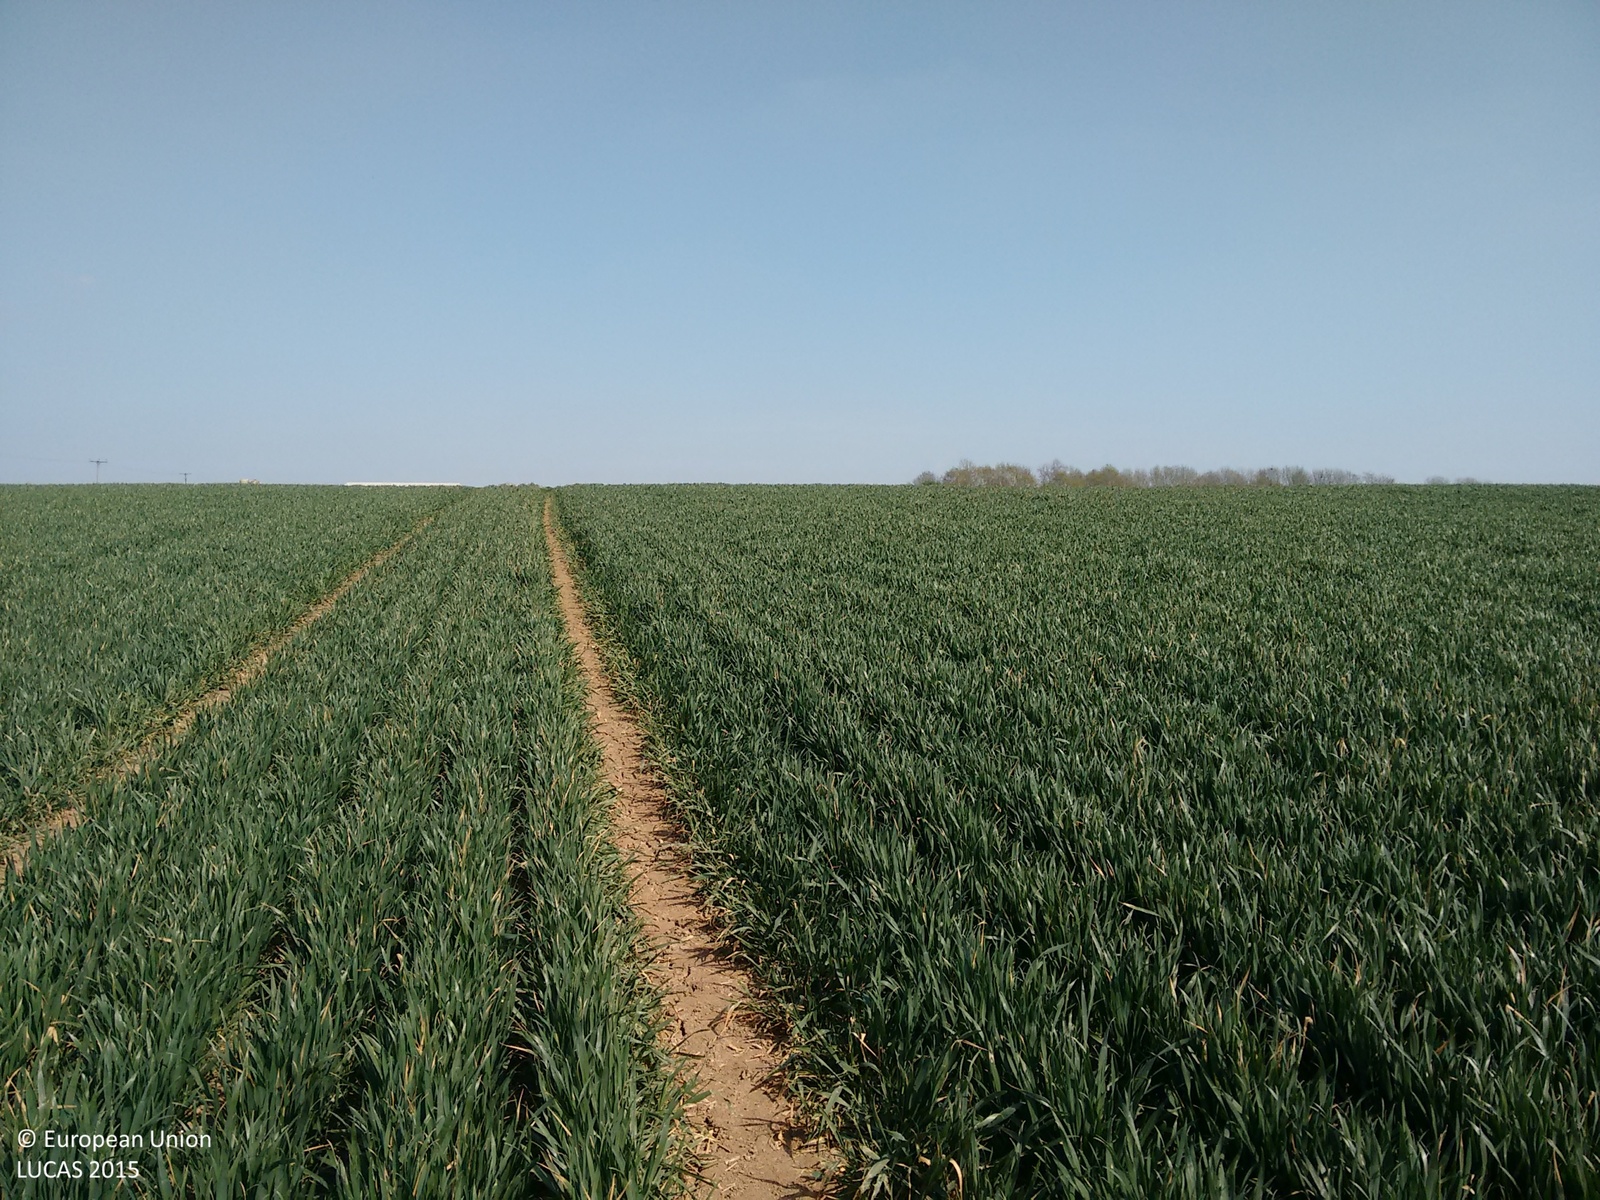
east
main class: Cropland
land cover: Common wheat
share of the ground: > 75 %
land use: Agriculture (excluding fallow land and kitchen gardens)
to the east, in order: Common wheat; Grass margins; Managed hedges; Fences; Grassland without tree/shrub cover
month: April
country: GB
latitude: 53.2914
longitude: -0.6759
